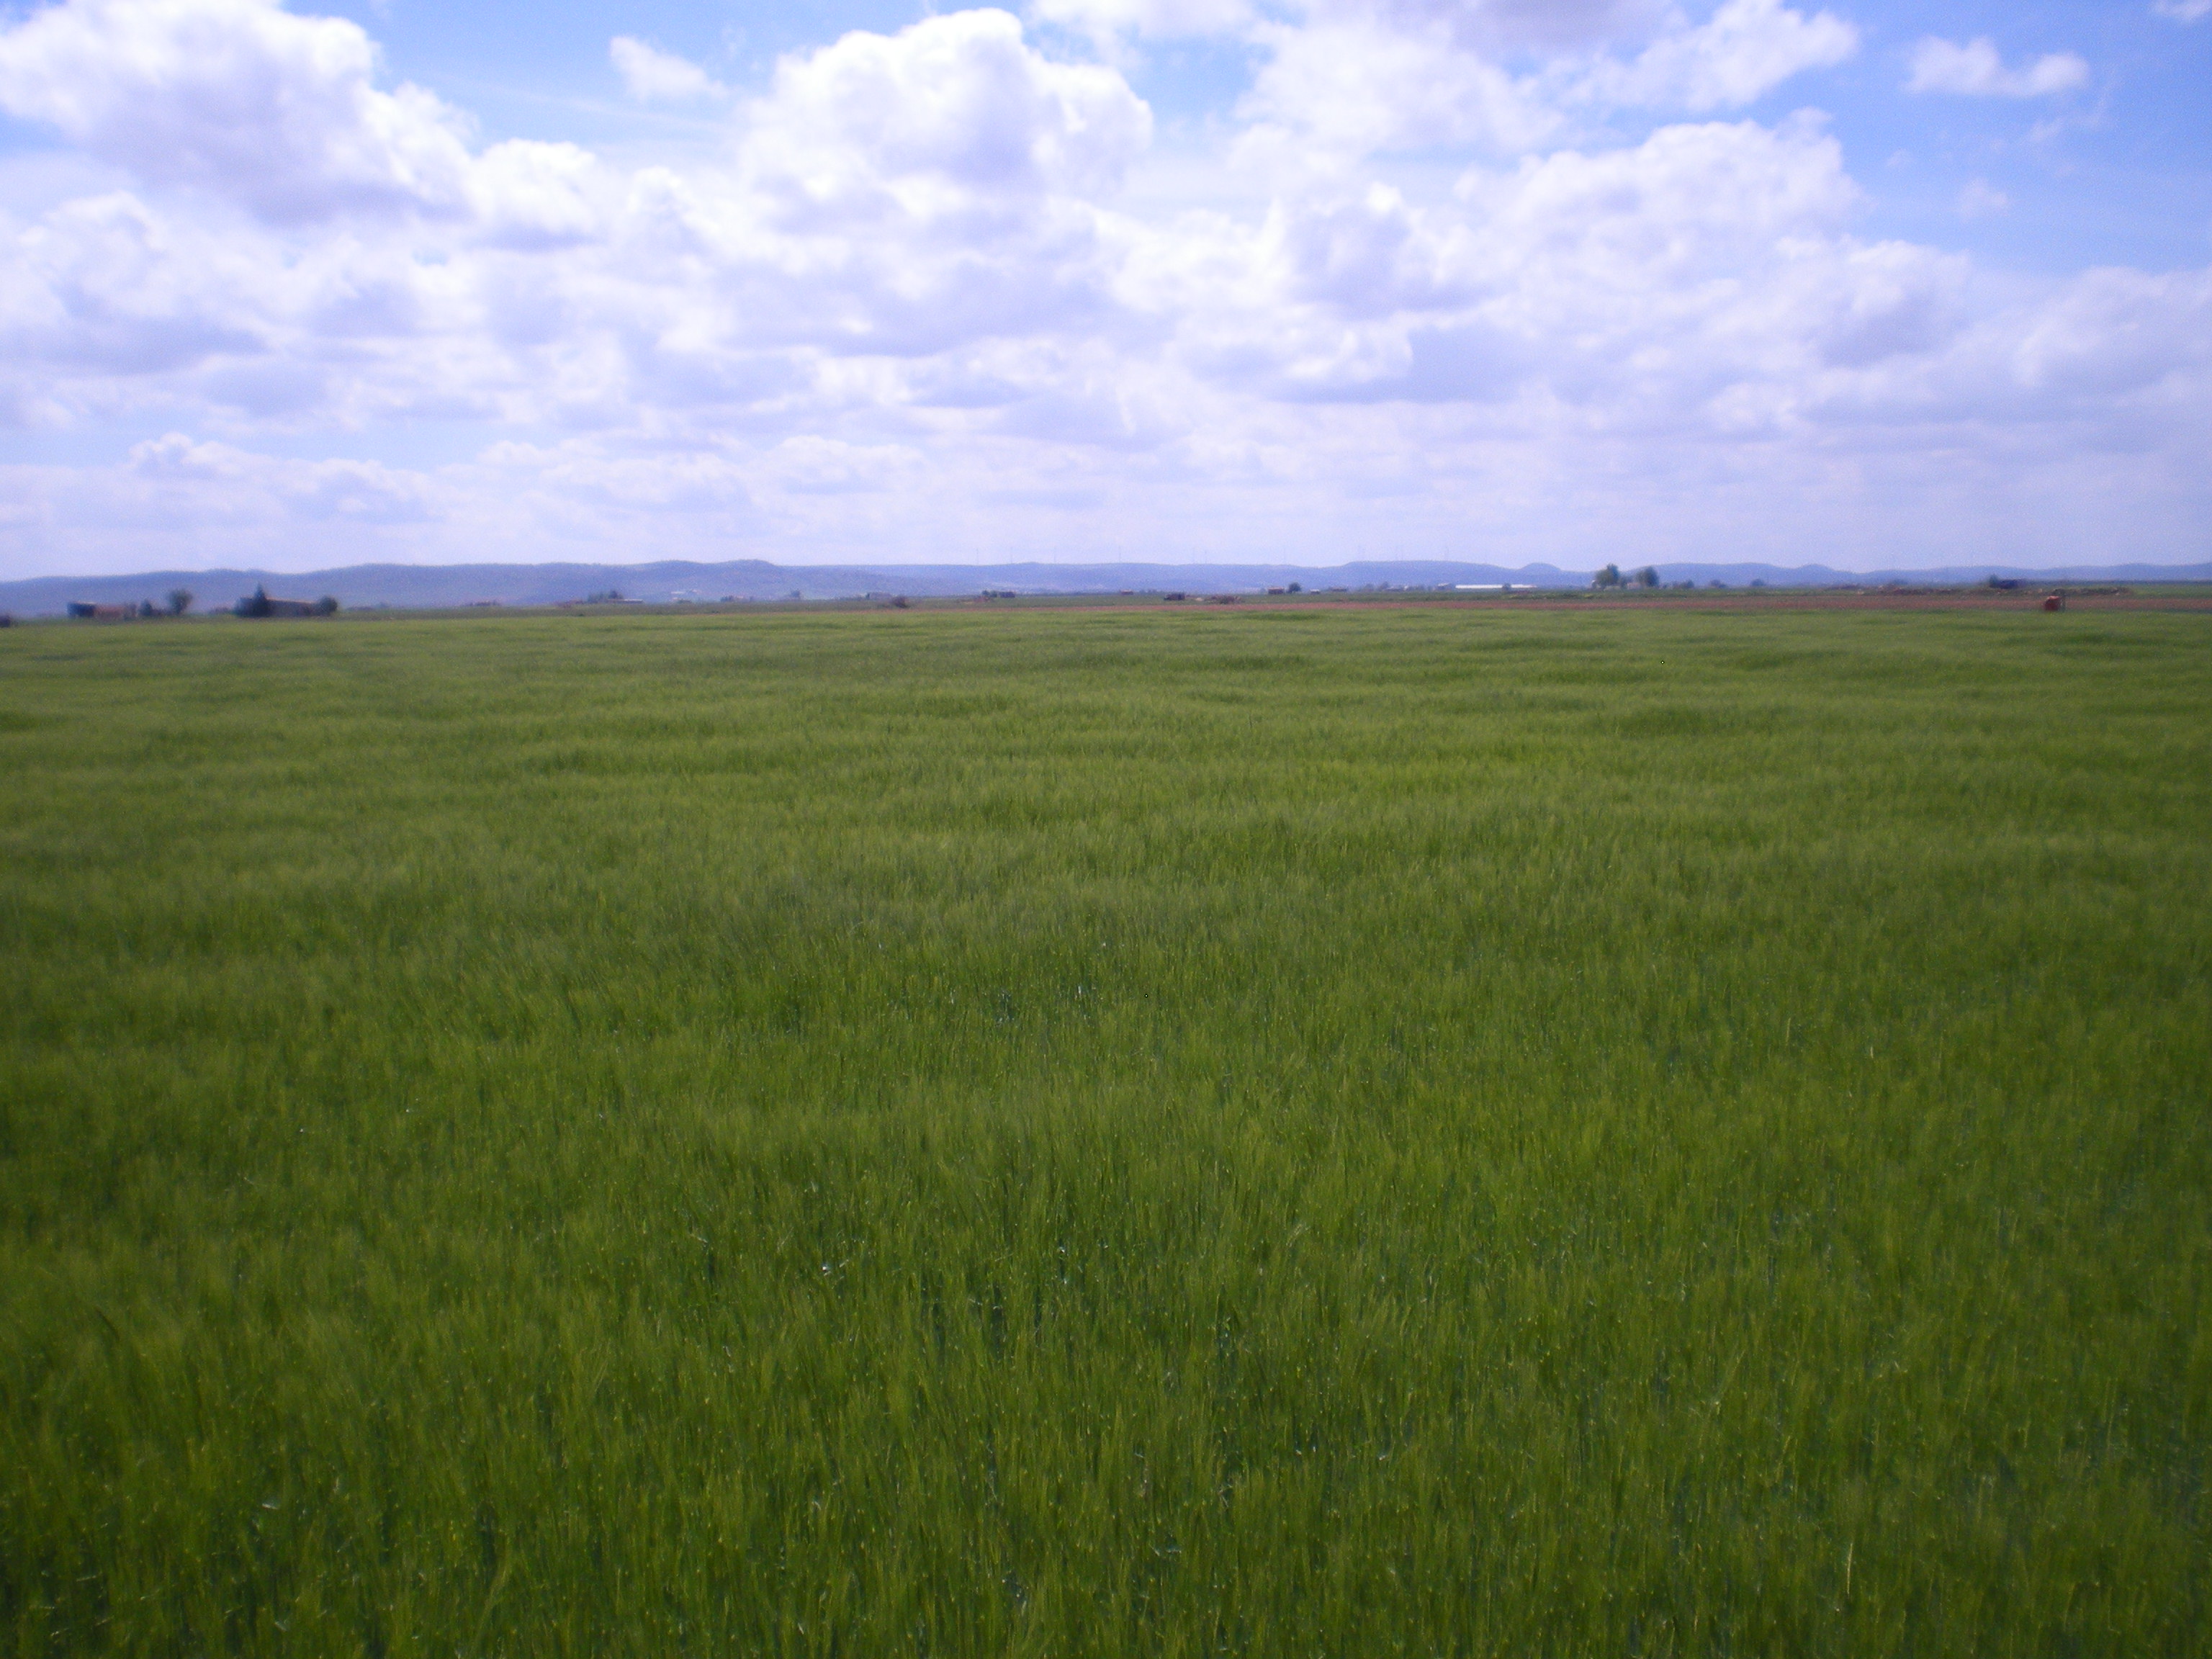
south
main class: Cropland
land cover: Barley
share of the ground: > 75 %
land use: Agriculture (excluding fallow land and kitchen gardens)
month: April
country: ES
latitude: 38.9882
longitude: -3.5815
